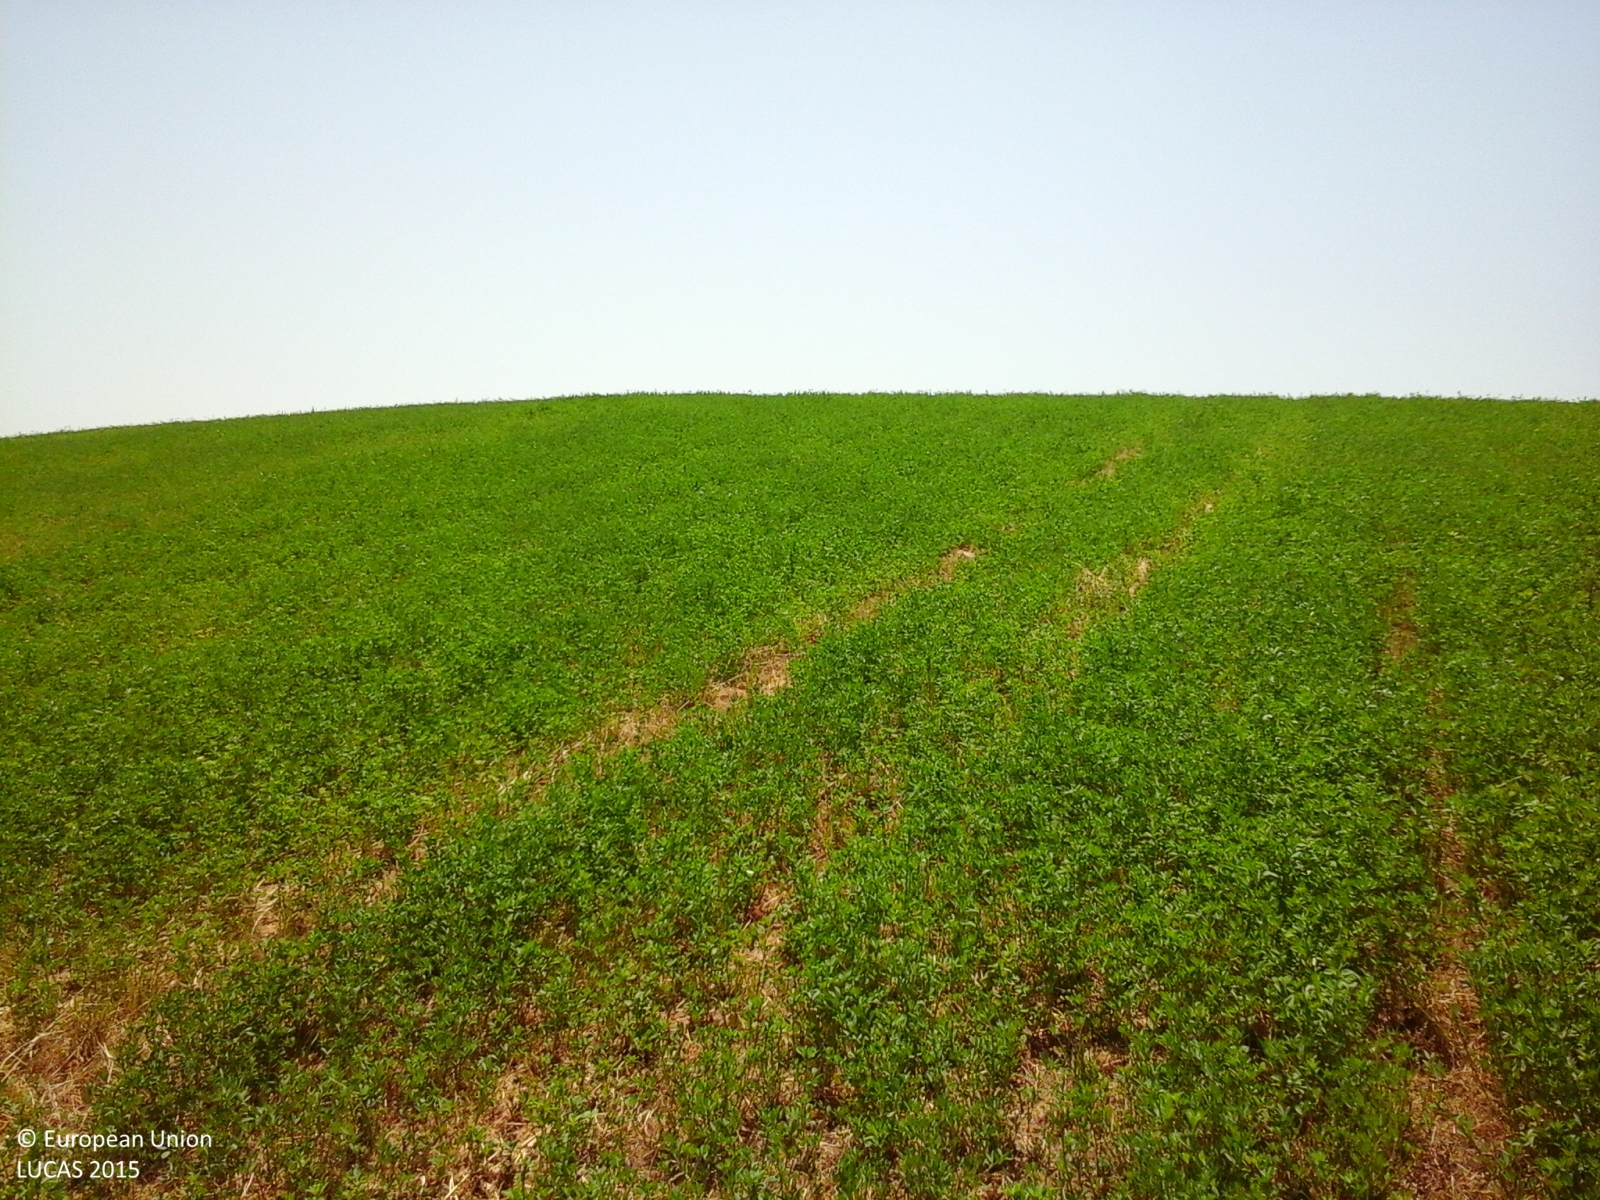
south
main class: Cropland
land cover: Lucerne
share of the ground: > 75 %
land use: Agriculture (excluding fallow land and kitchen gardens)
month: July
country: IT
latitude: 43.1220
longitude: 13.3710
